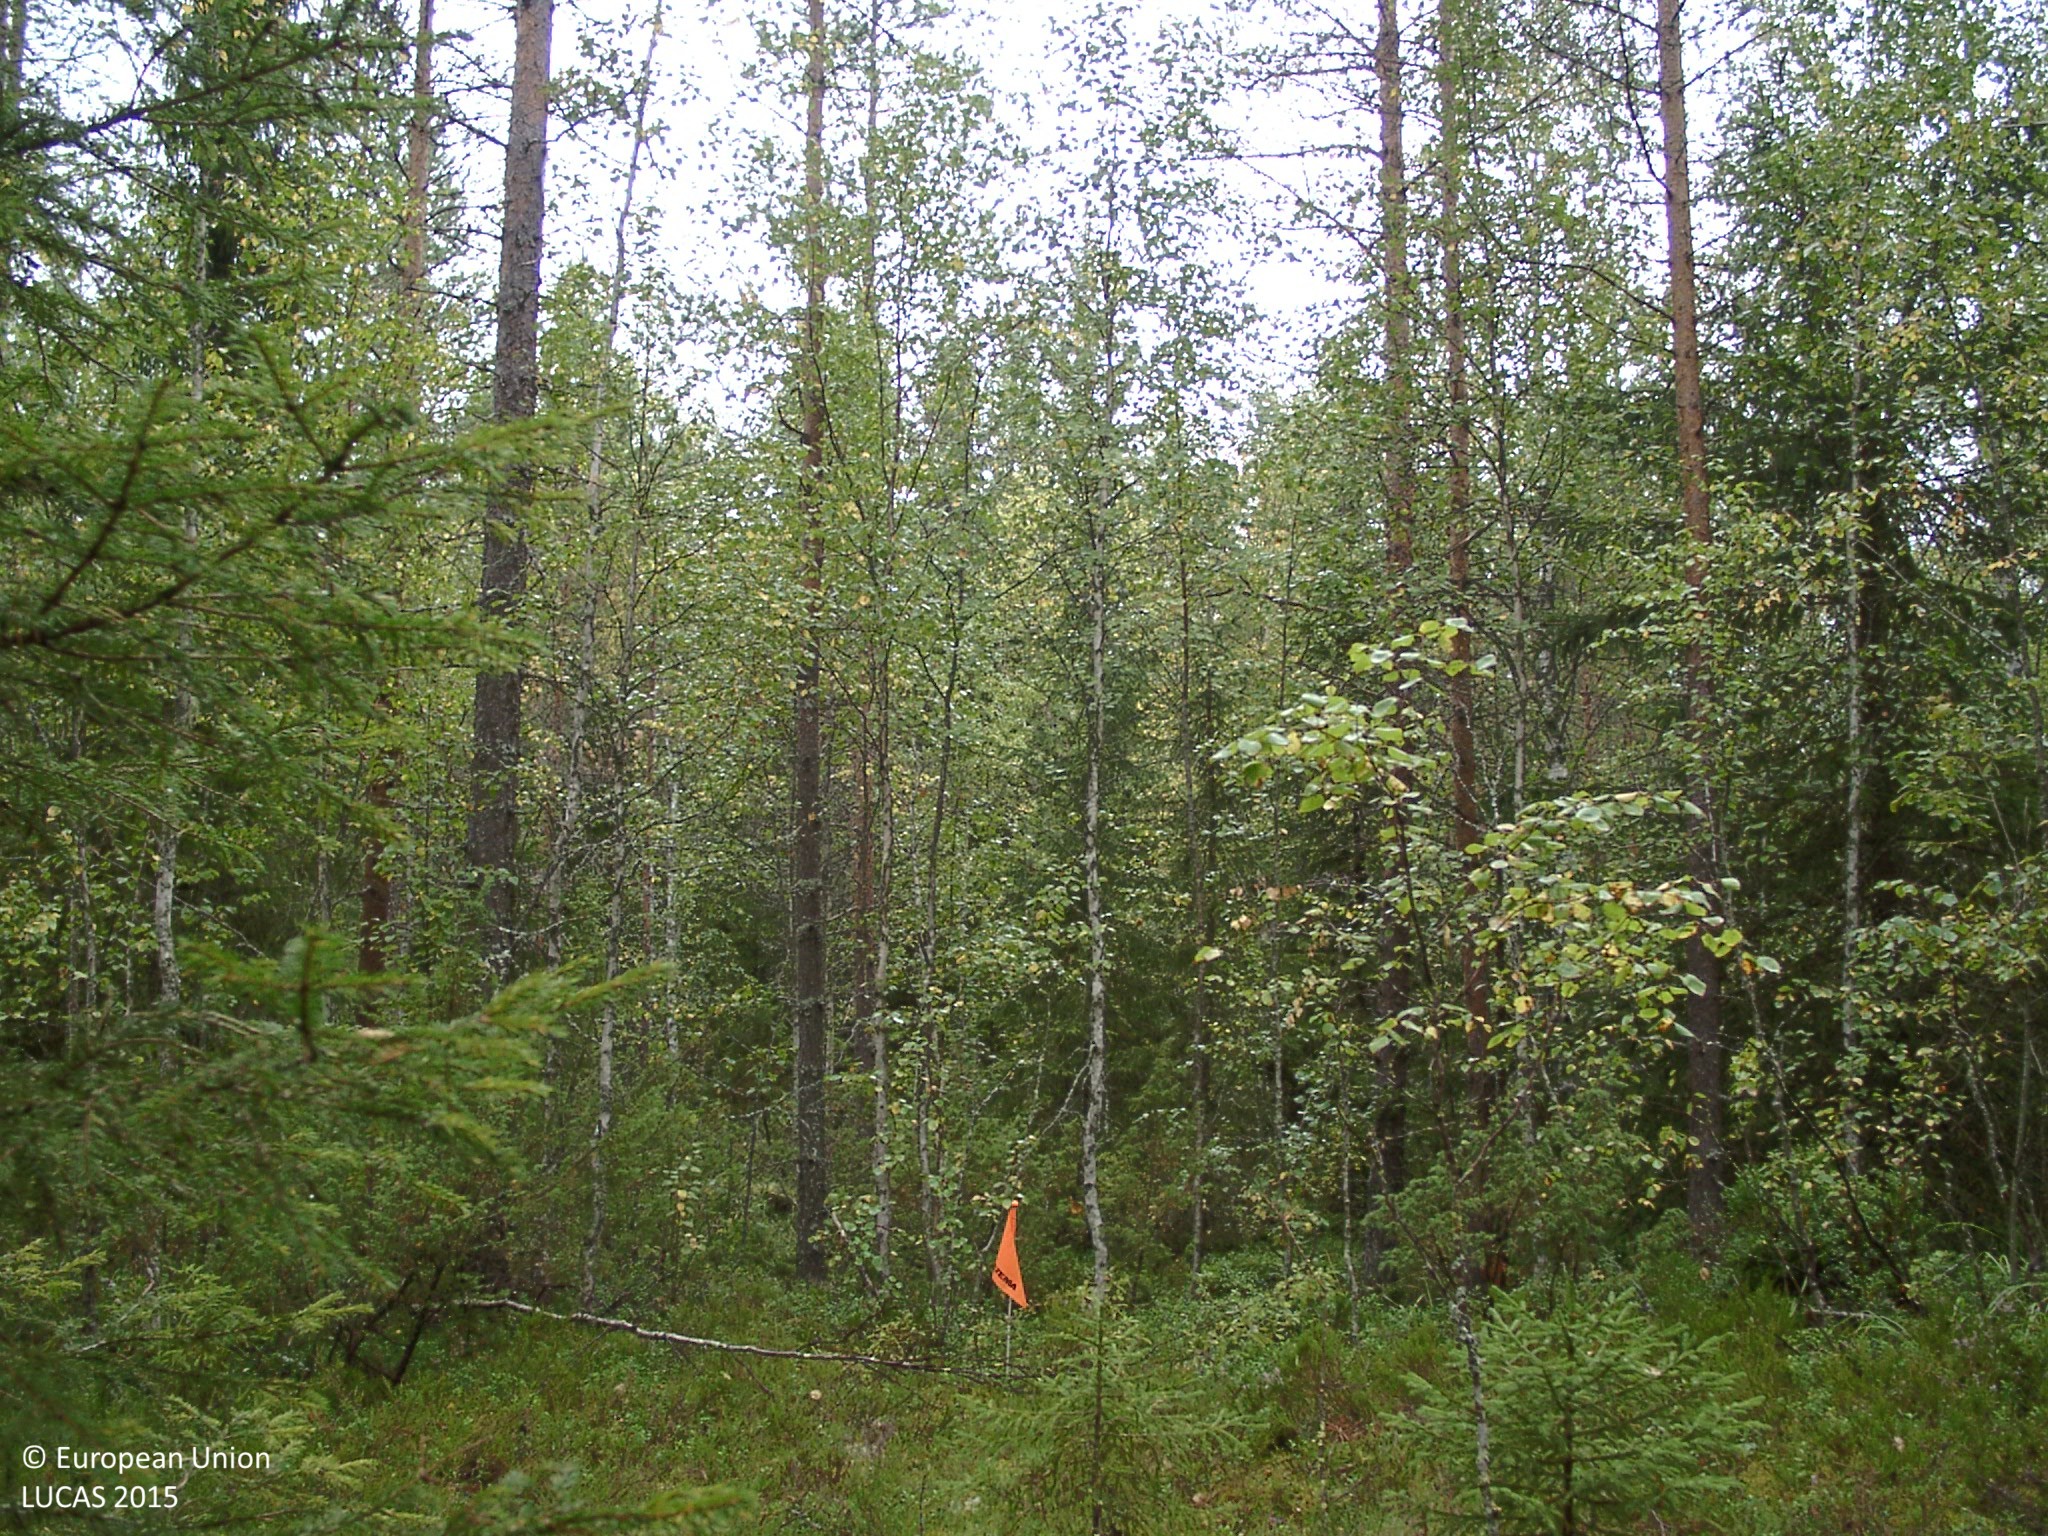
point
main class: Woodland
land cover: Pine dominated mixed woodland
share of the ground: 50 - 75 %
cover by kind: coniferous forest trees 35 %, broadleaved forest trees 25 %, shrubs 25 %, lichens and mosses 10 %, herbaceous plants 5 %
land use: Forestry
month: August
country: FI
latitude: 62.4790
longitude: 25.0187
